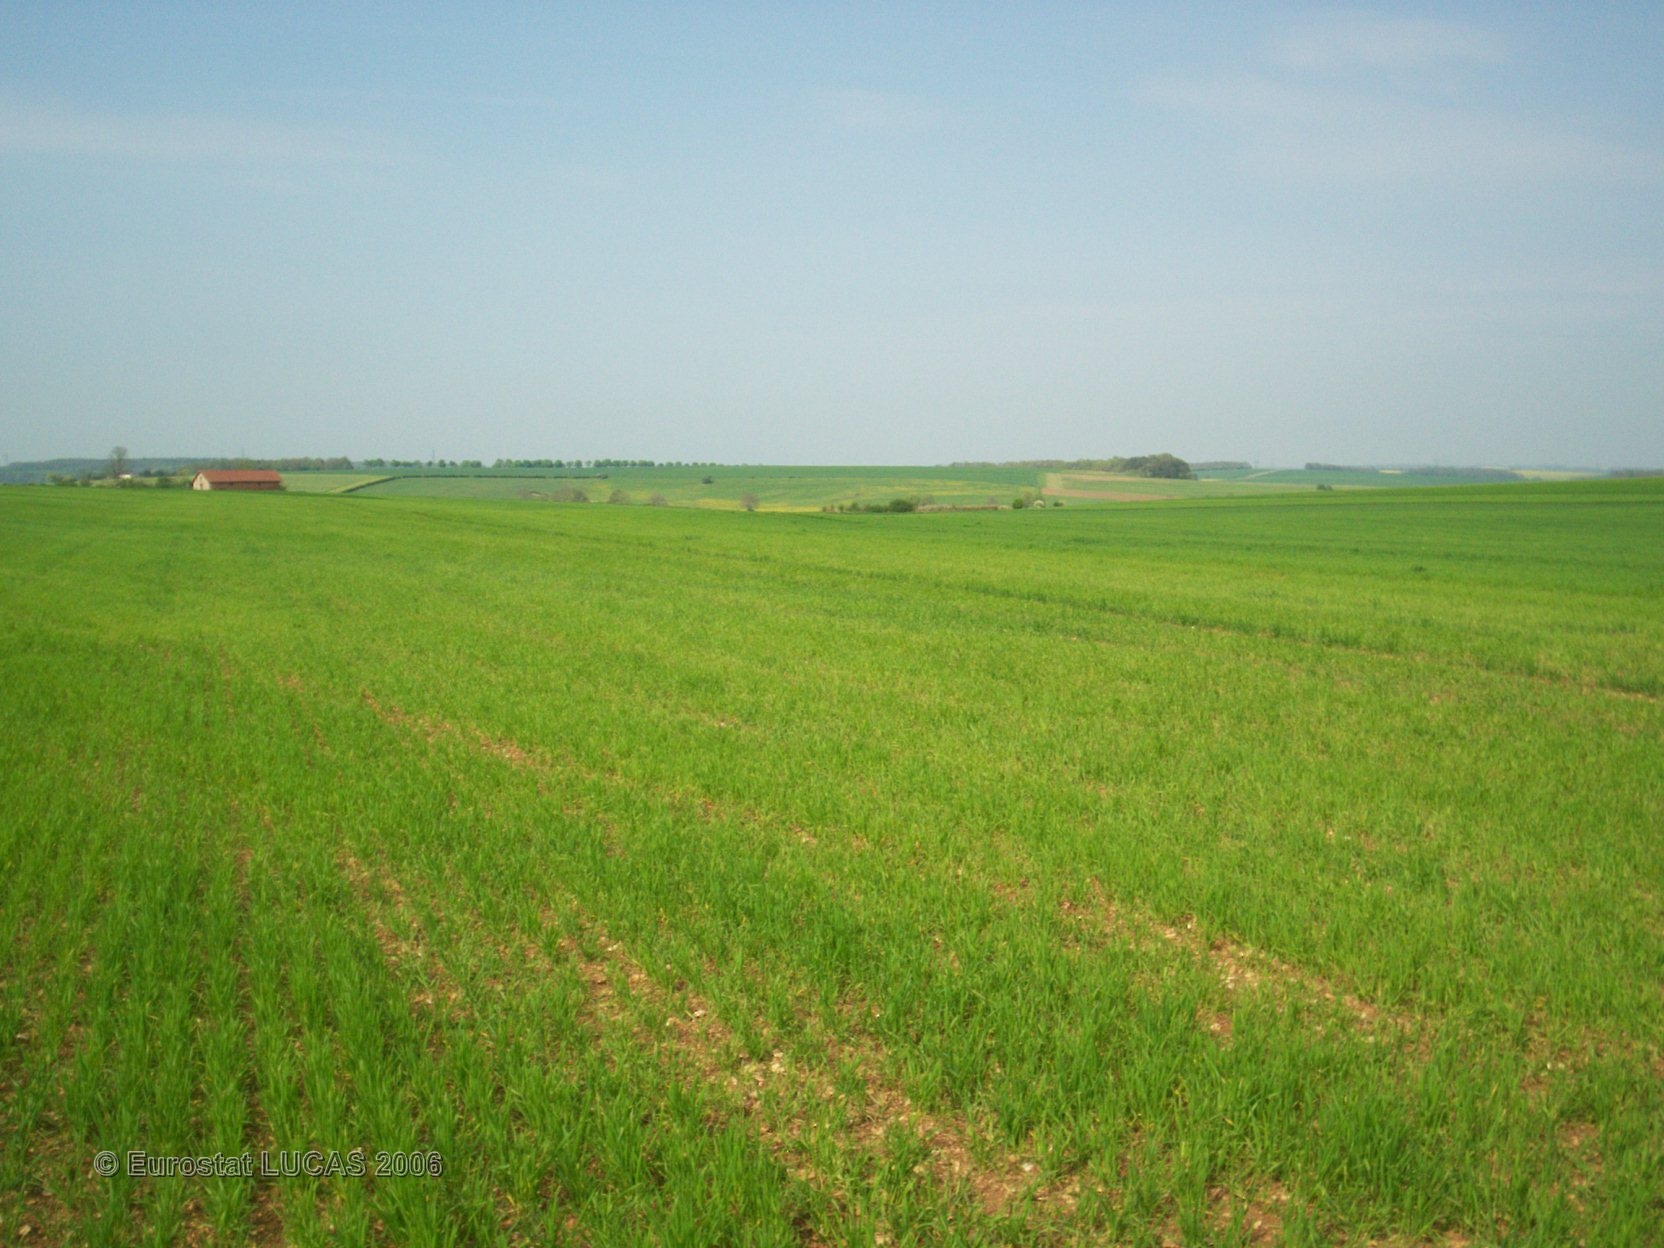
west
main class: Cropland
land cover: Common wheat
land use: Agriculture (excluding fallow land and kitchen gardens)
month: May
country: FR
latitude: 47.5523
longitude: 4.6441
